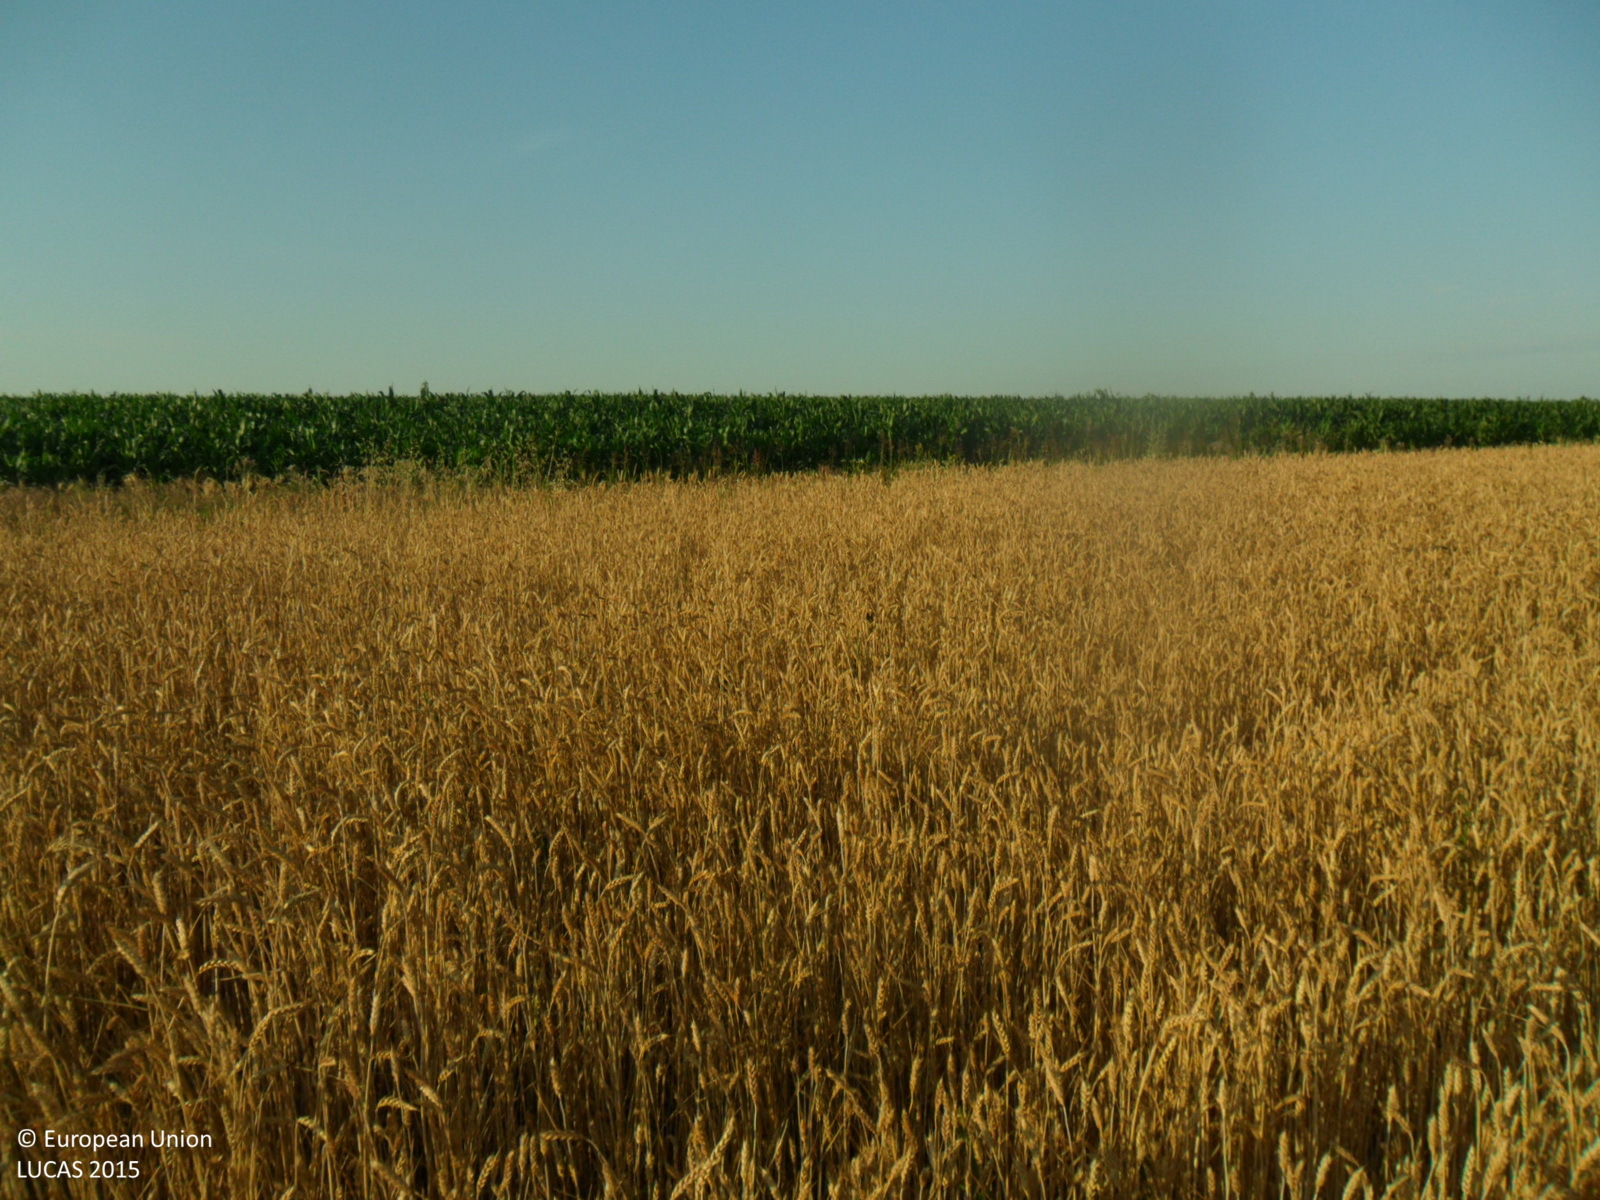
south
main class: Cropland
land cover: Common wheat
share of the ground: > 75 %
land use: Agriculture (excluding fallow land and kitchen gardens)
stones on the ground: < 10 %
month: July
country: BG
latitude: 43.6337
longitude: 26.7844
